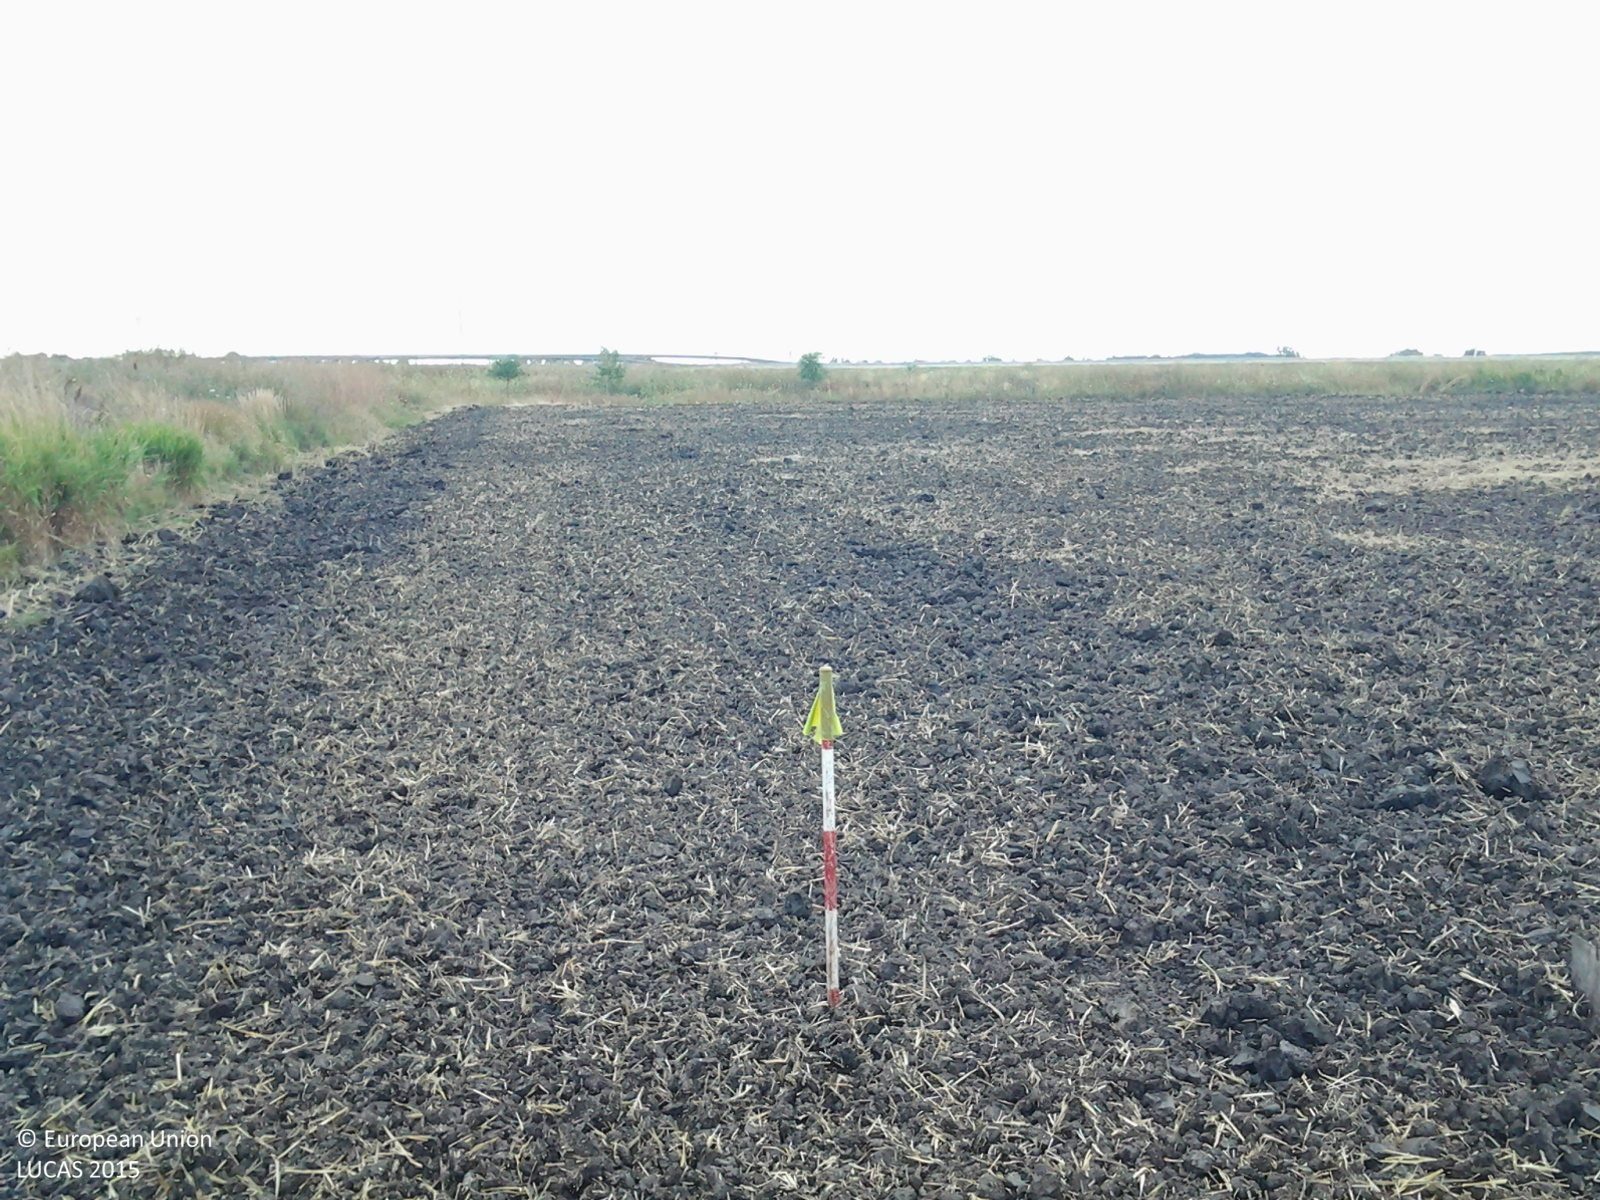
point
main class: Cropland
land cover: Common wheat
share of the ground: < 10 %
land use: Agriculture (excluding fallow land and kitchen gardens)
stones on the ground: < 10 %
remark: Harvested field
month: July
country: HU
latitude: 47.2402
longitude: 20.7729
